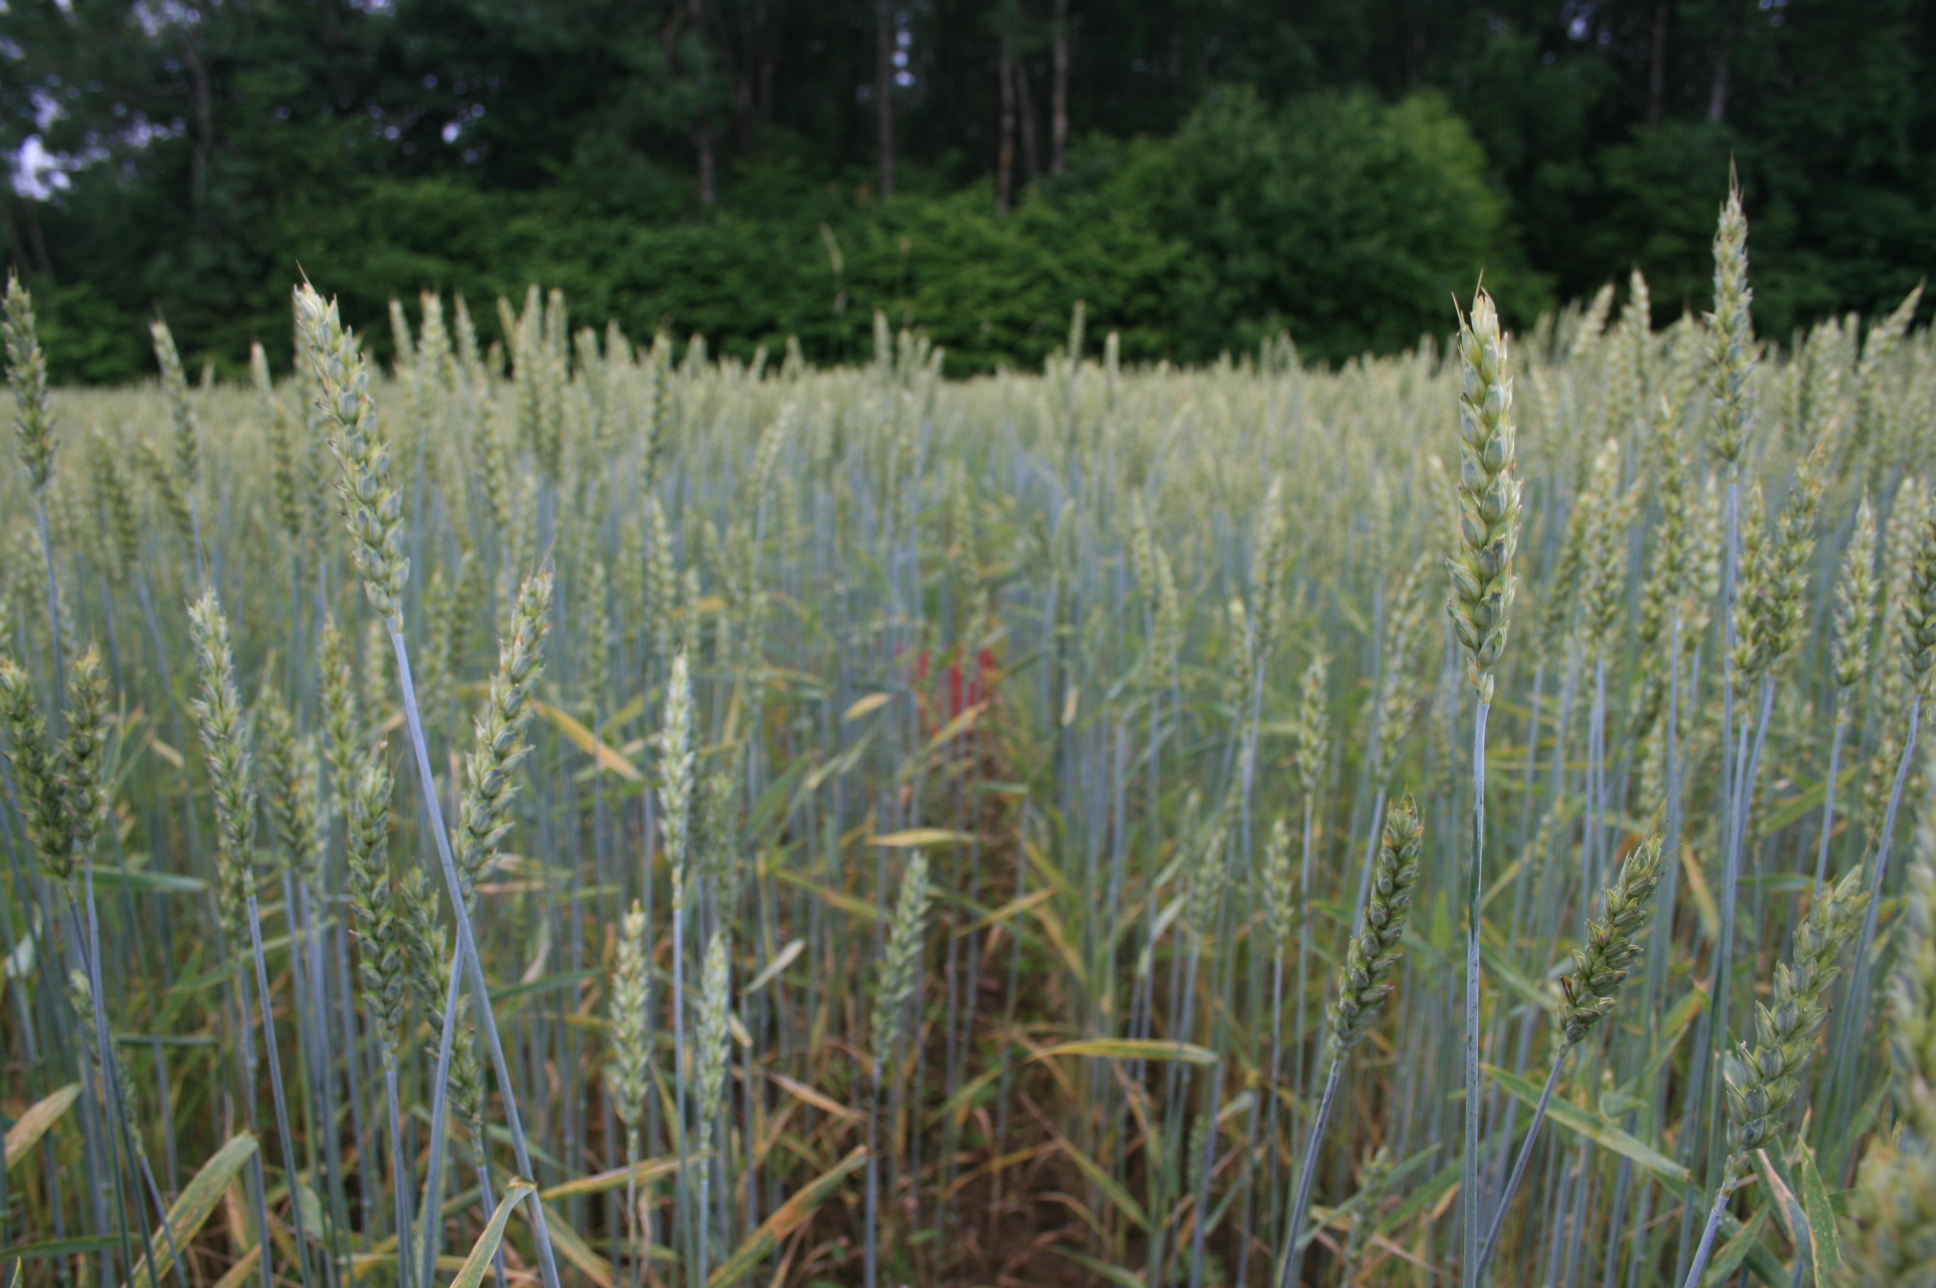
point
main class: Cropland
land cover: Common wheat
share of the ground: > 75 %
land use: Agriculture (excluding fallow land and kitchen gardens)
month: July
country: LT
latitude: 55.5238
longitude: 22.0769
